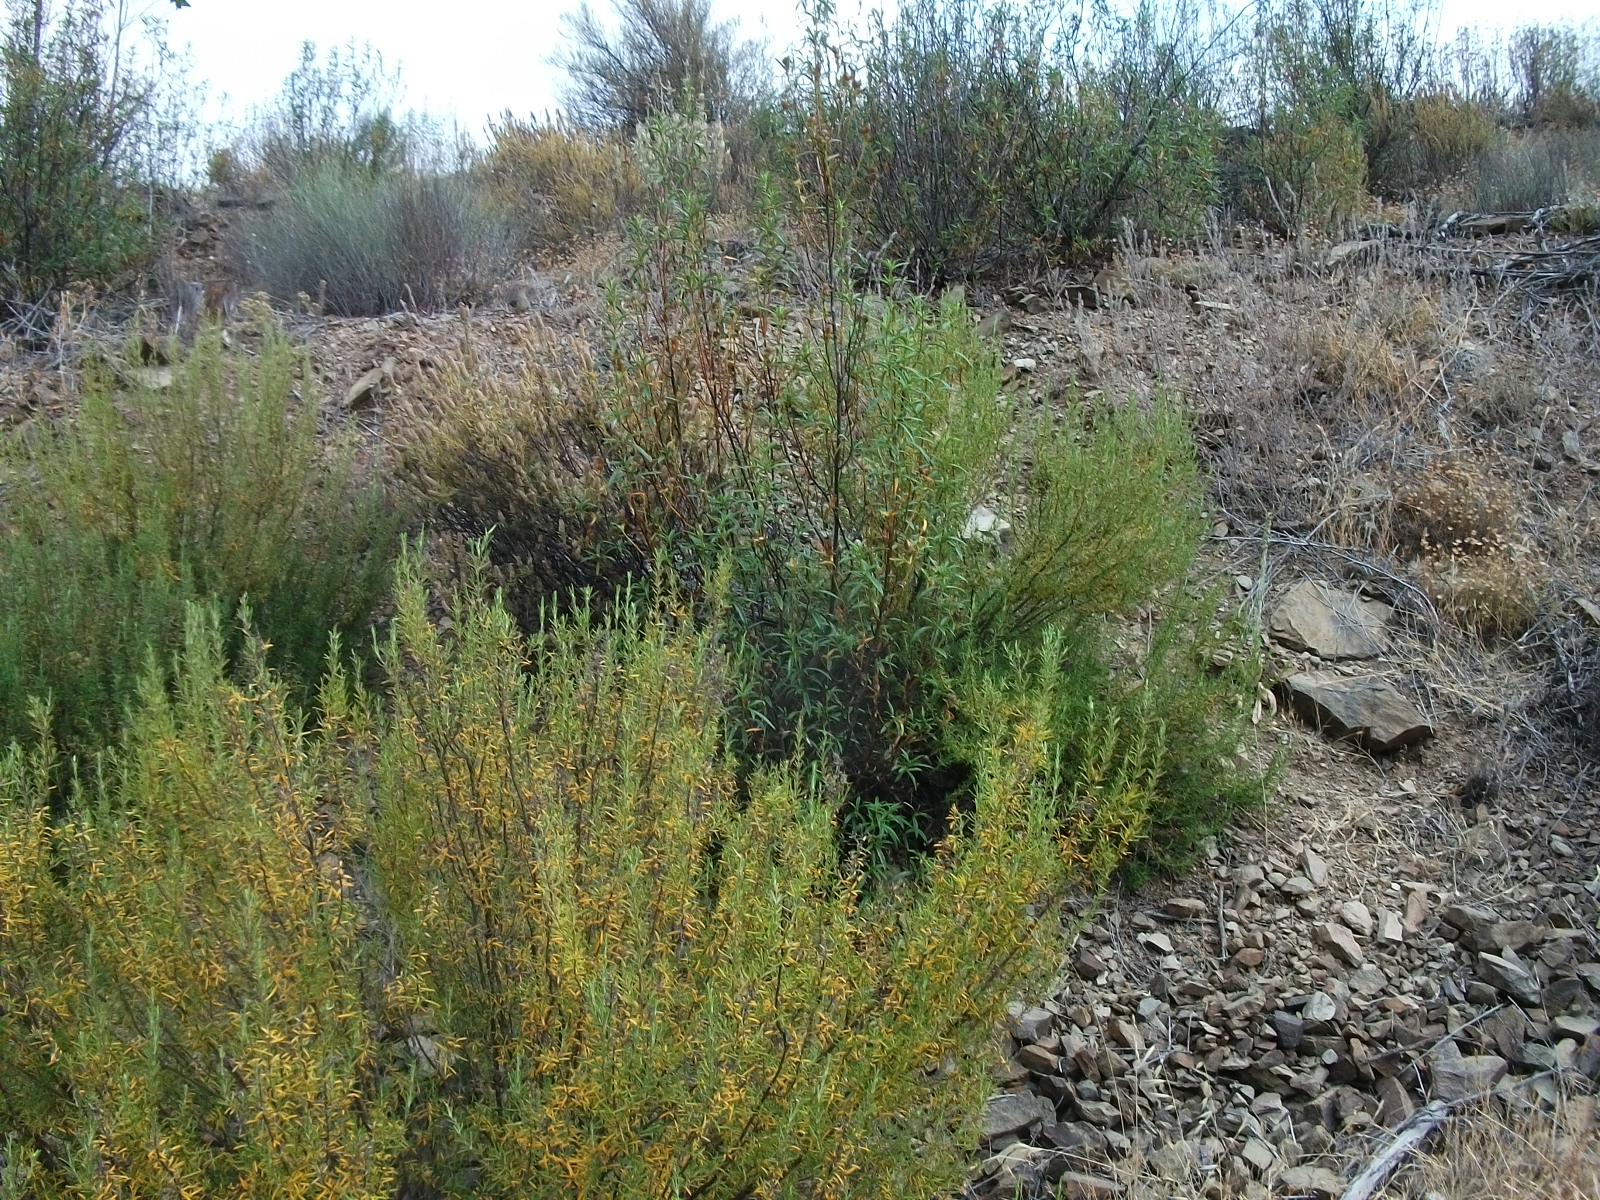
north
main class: Woodland
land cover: Broadleaved woodland
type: exotic forest
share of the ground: 10 - 25 %
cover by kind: shrubs 65 %, broadleaved forest trees 25 %, herbaceous plants 10 %
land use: Forestry
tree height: > 5 m
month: June
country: ES
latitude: 37.4923
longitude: -6.9290
